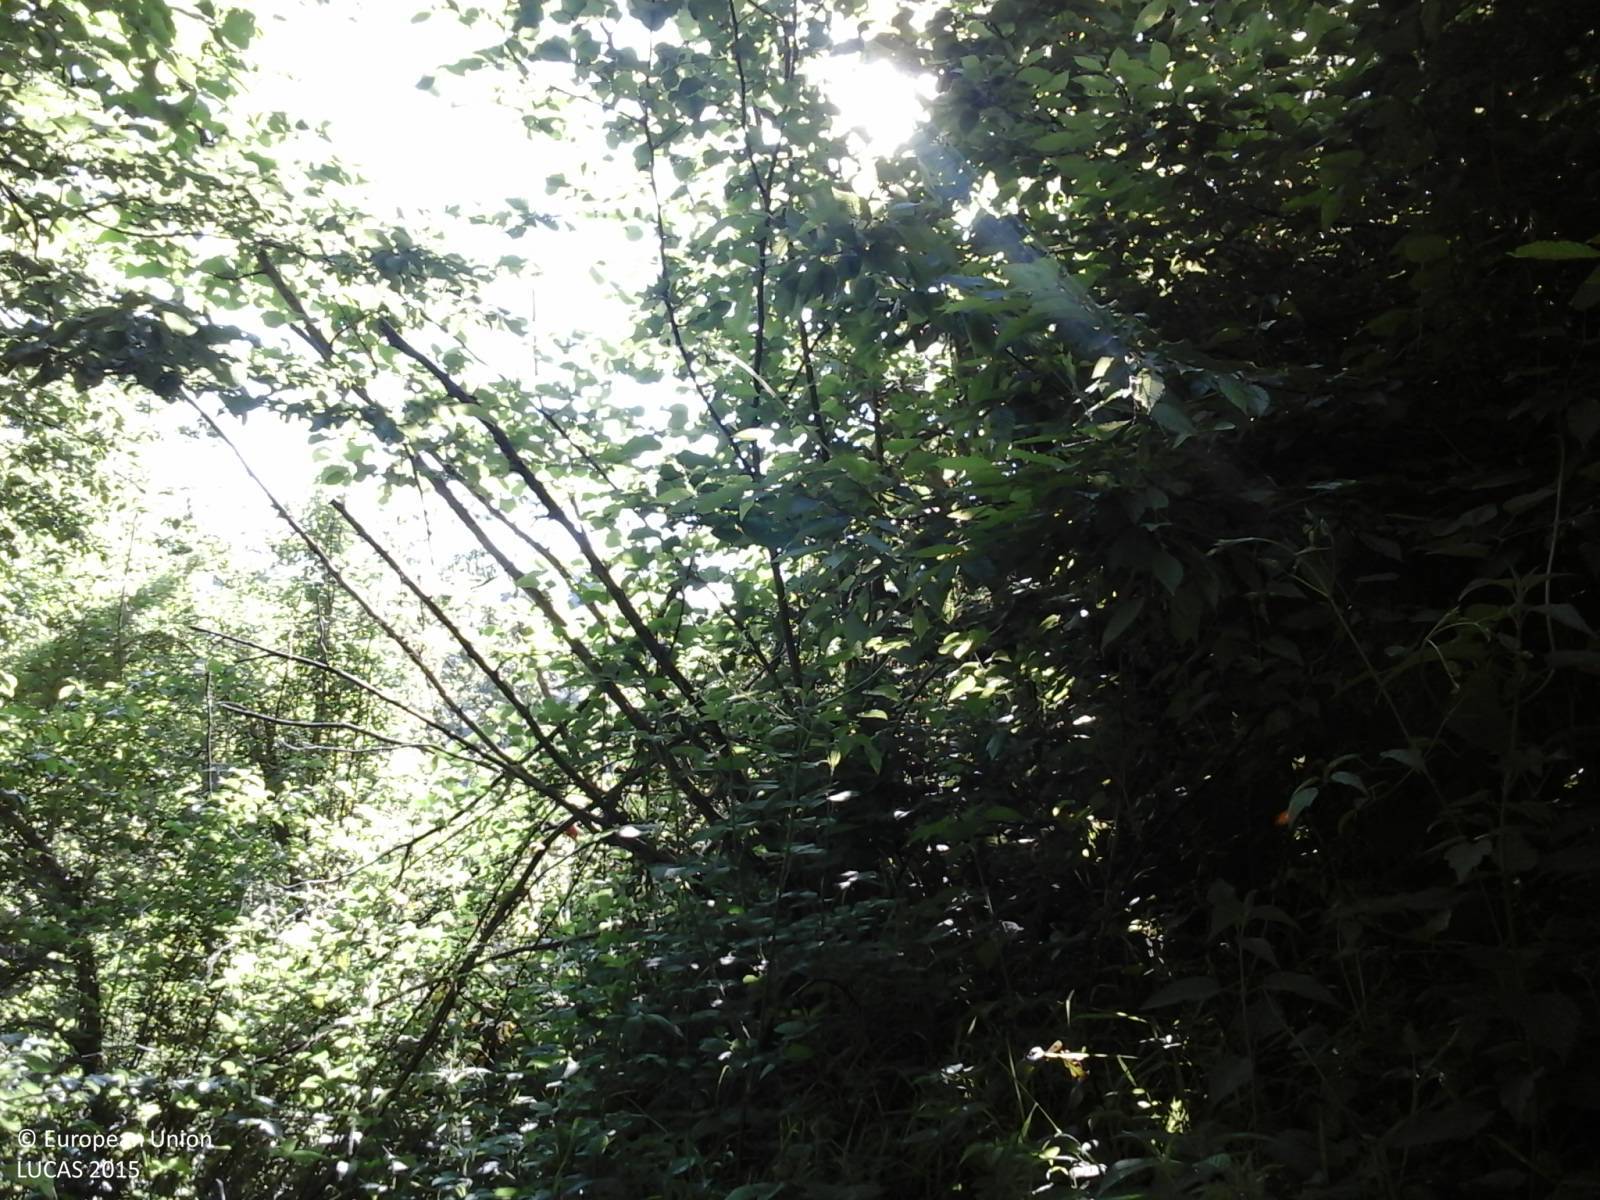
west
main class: Shrubland
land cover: Shrubland with sparse tree cover
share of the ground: > 75 %
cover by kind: shrubs 90 %, broadleaved forest trees 5 %, herbaceous plants 5 %
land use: Semi-natural and natural areas not in use
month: May
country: IT
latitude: 42.1352
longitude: 13.1469
